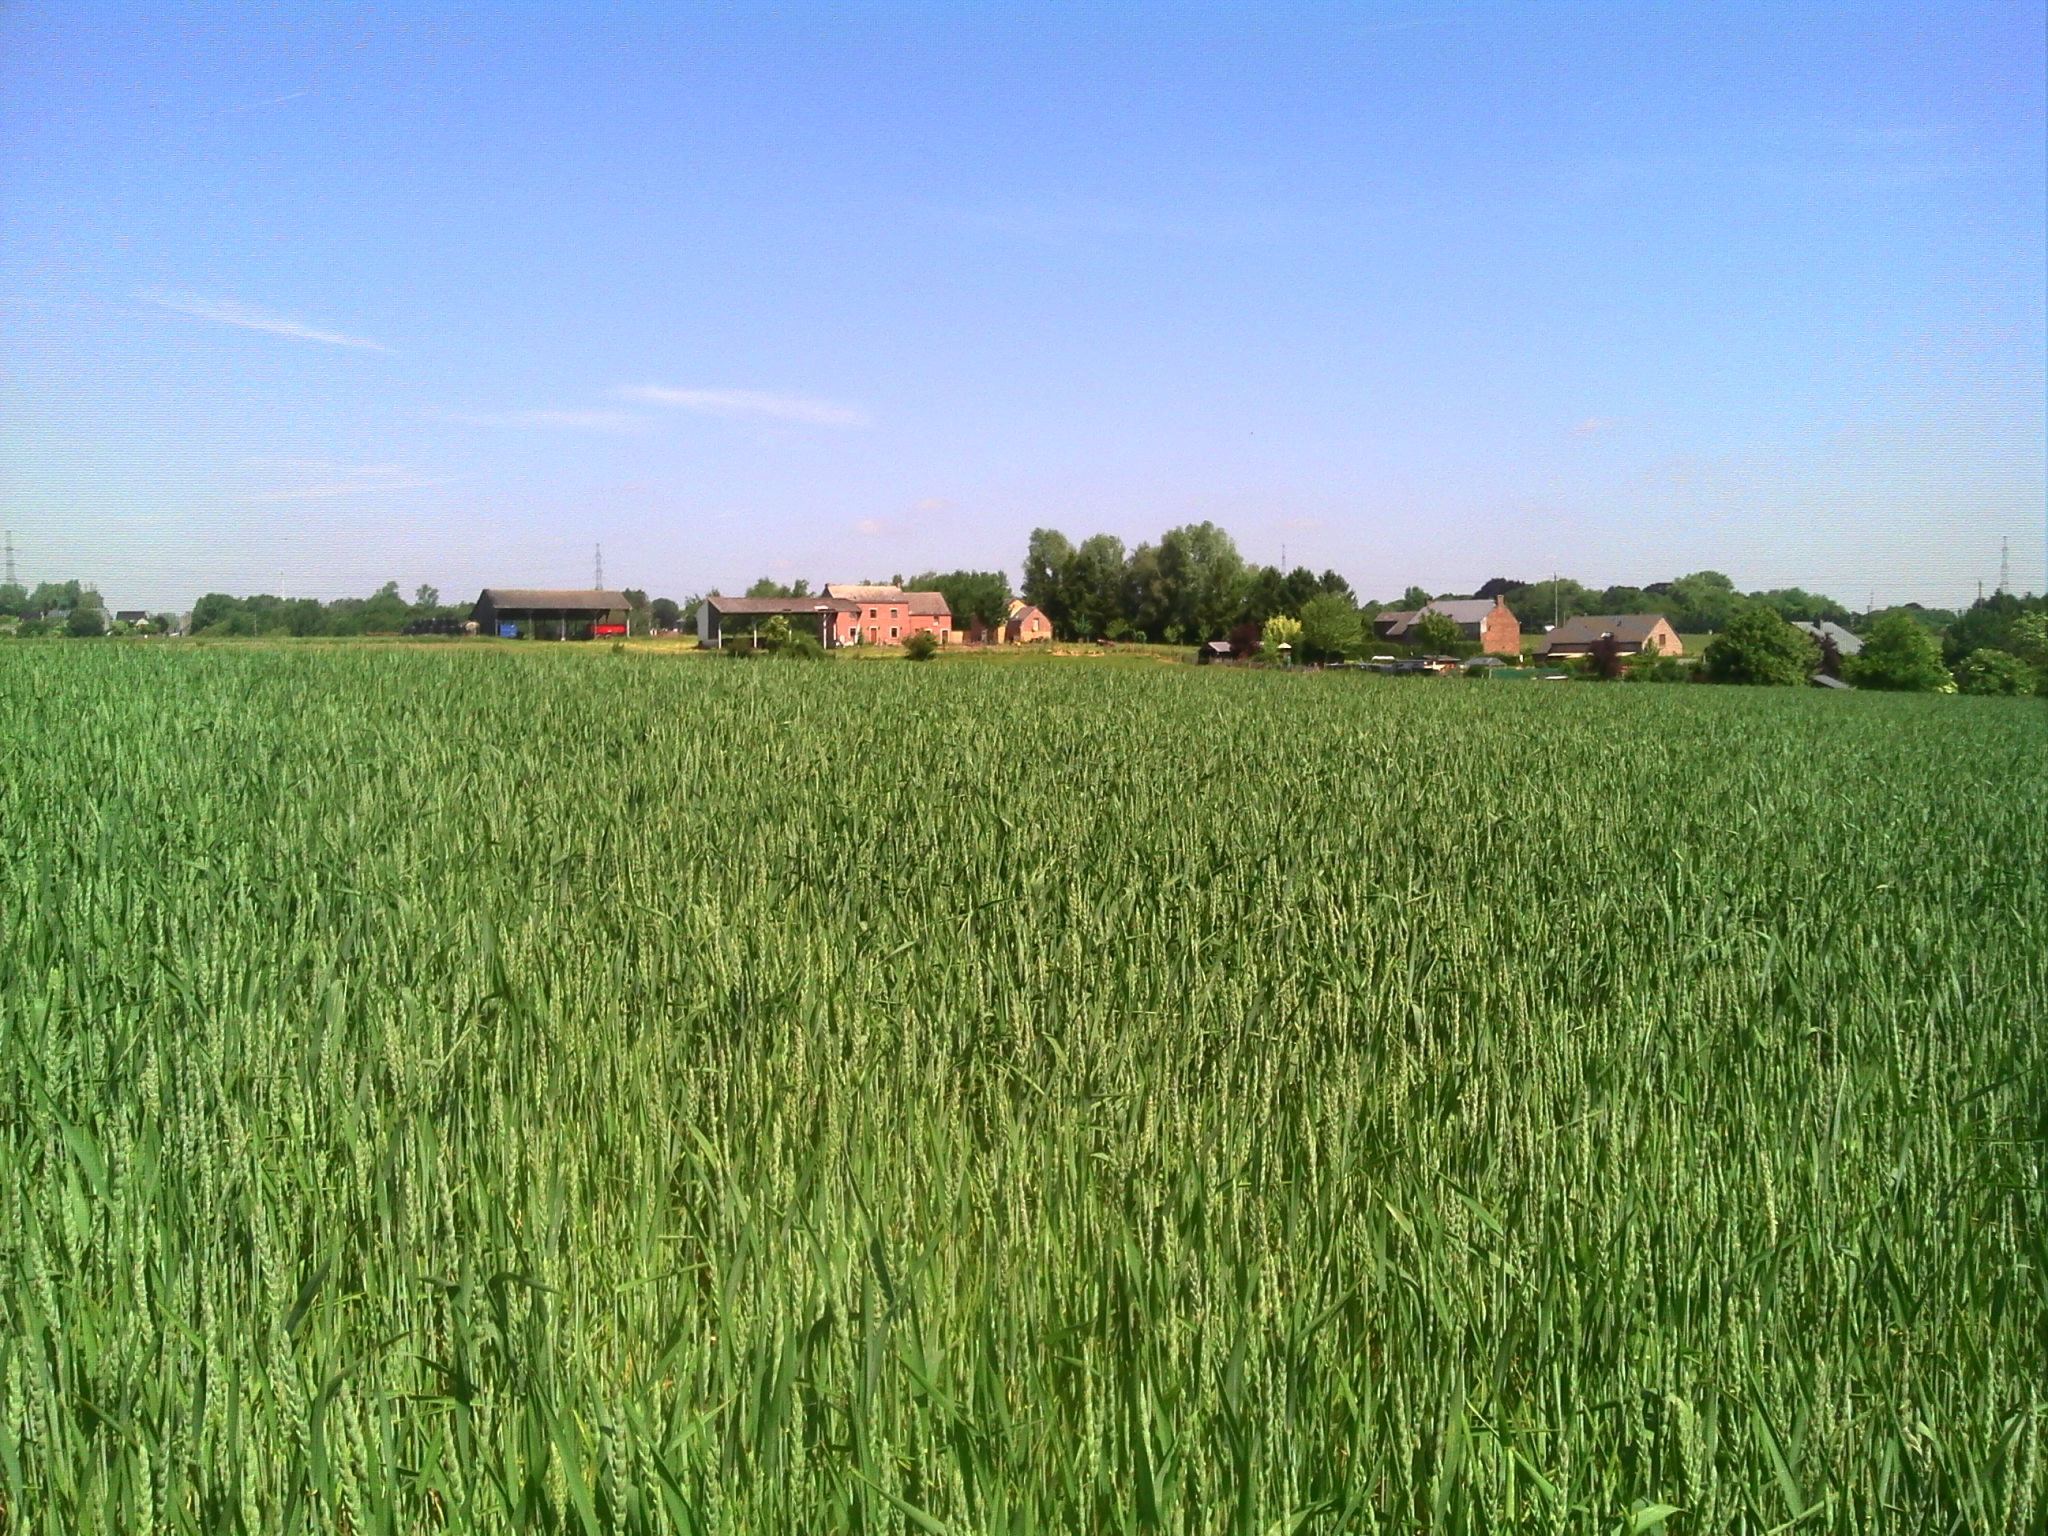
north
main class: Cropland
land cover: Common wheat
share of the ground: > 75 %
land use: Agriculture (excluding fallow land and kitchen gardens)
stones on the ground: < 10 %
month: June
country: BE
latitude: 50.4978
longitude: 4.7946
